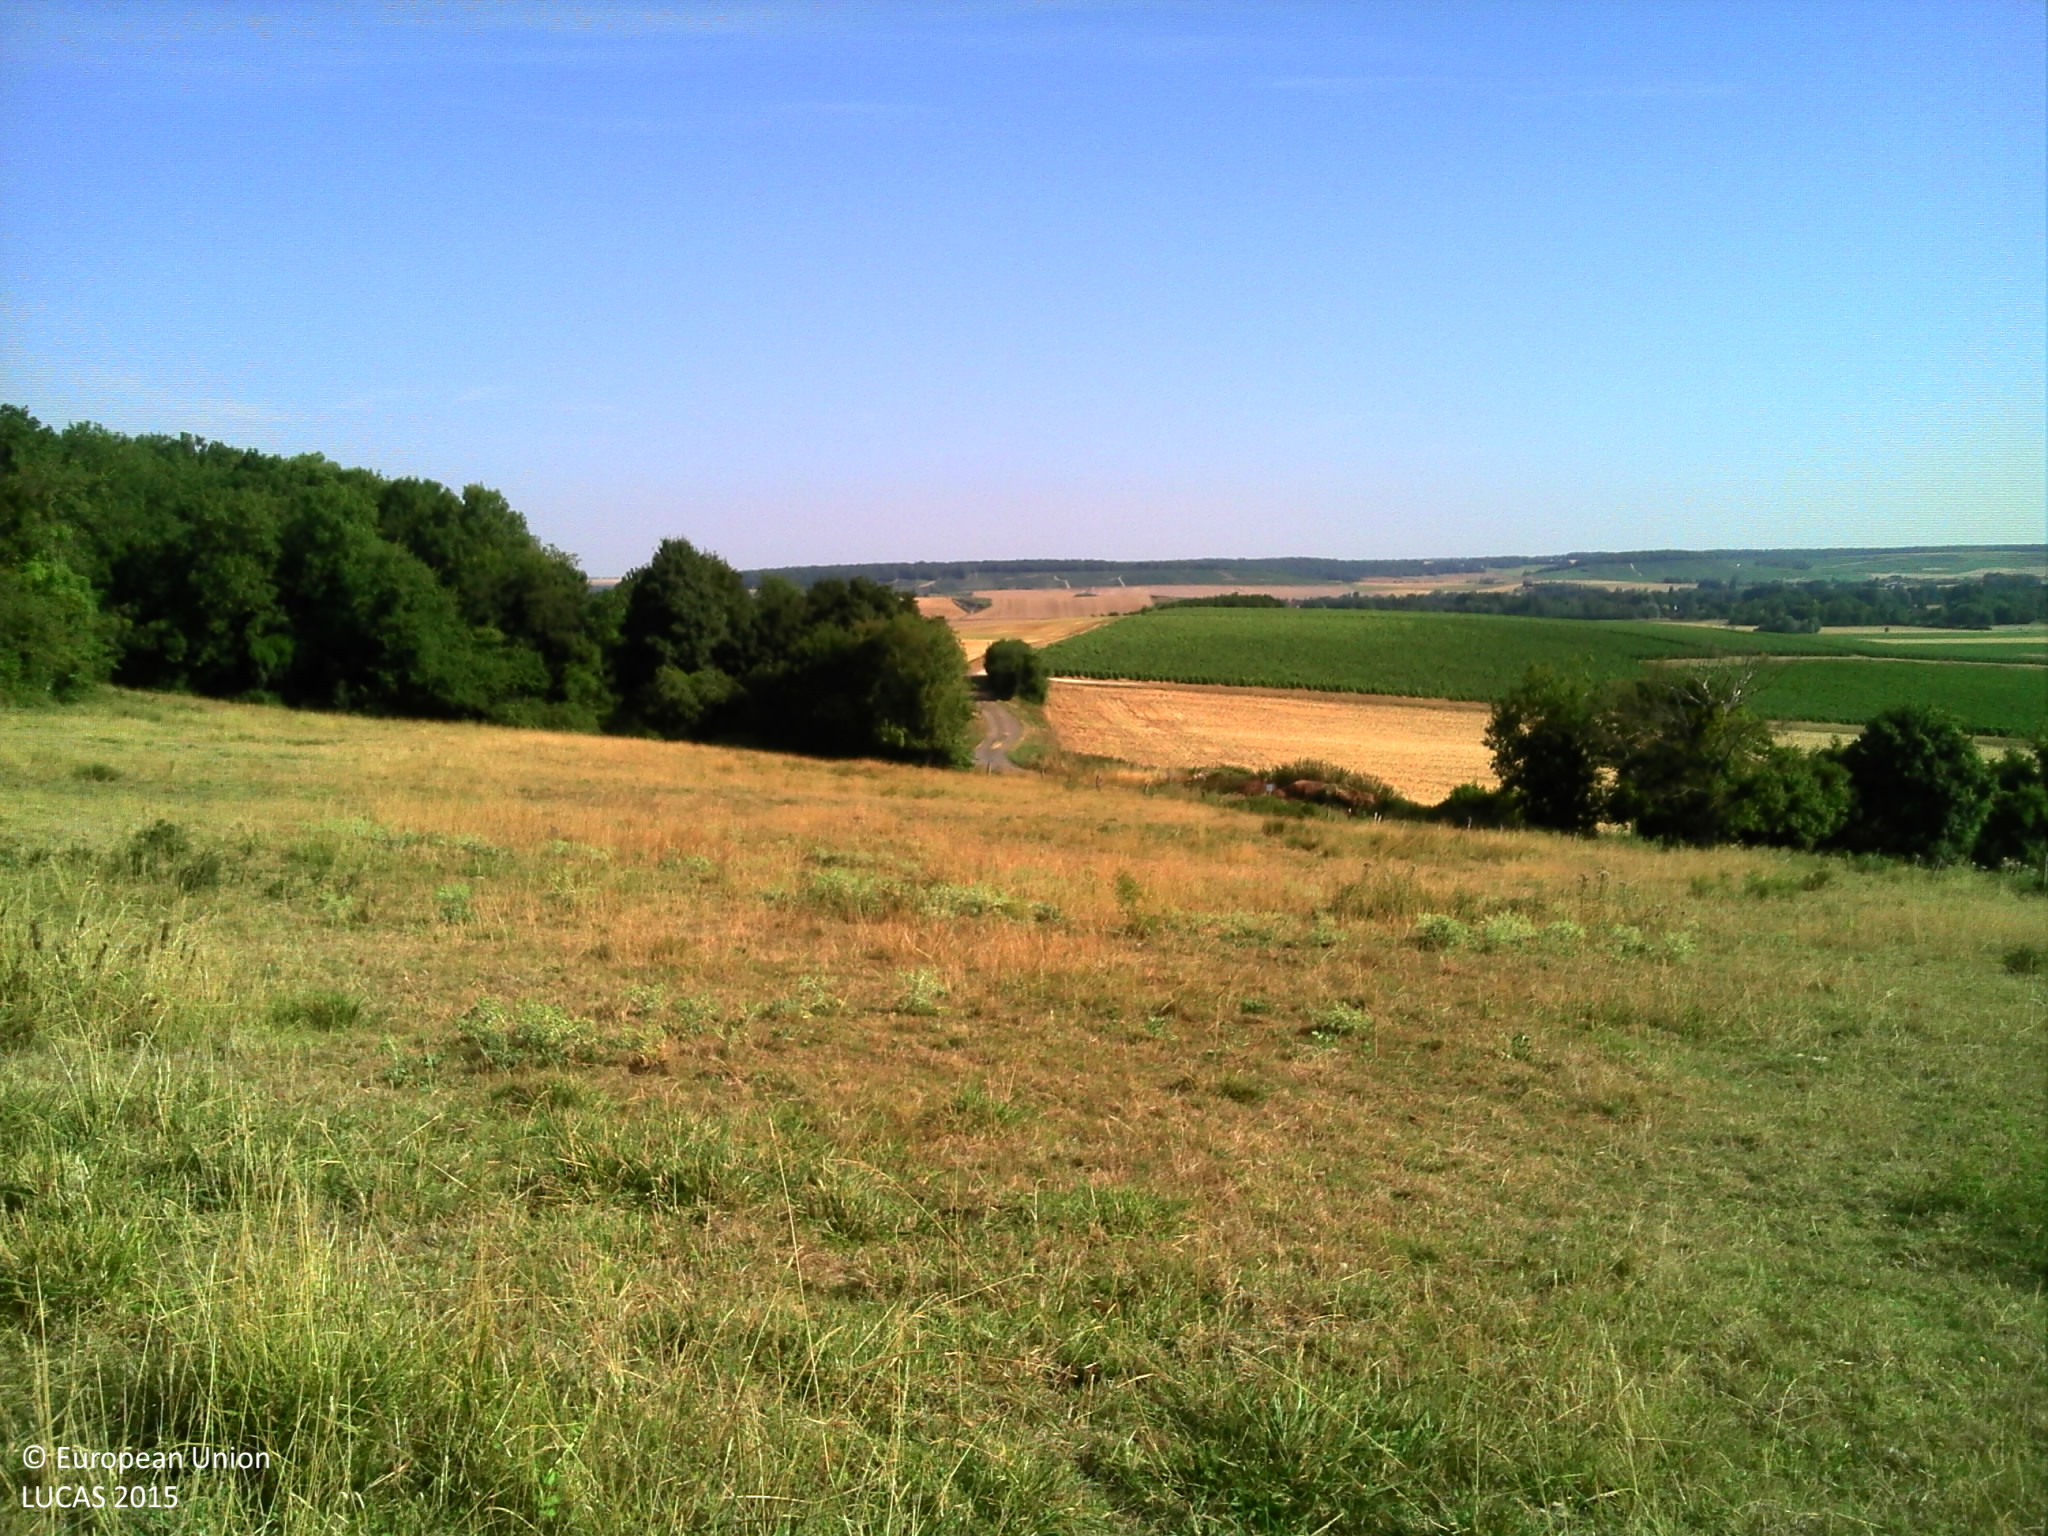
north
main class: Grassland
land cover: Grassland without tree/shrub cover
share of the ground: > 75 %
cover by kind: herbaceous plants 85 %, unconsolidated bare surface 10 %
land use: Agriculture (excluding fallow land and kitchen gardens)
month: August
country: FR
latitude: 48.7874
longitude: 3.7744
